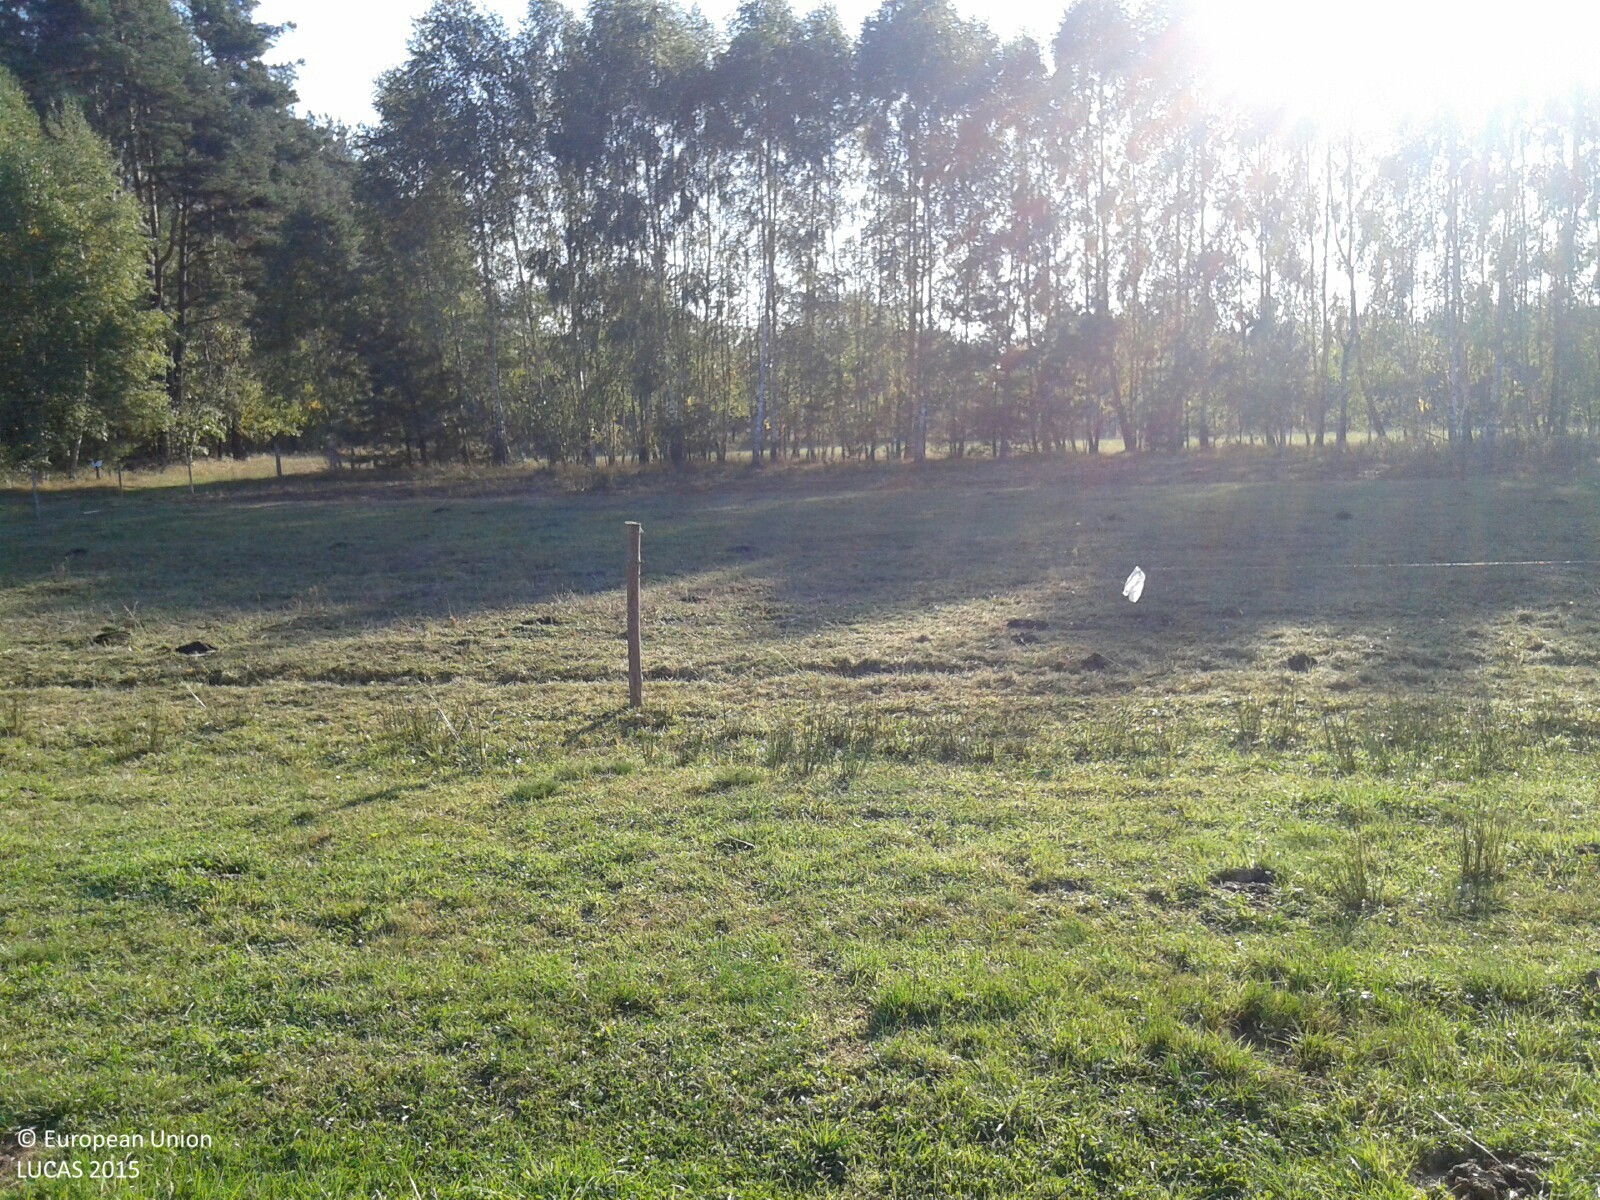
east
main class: Grassland
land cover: Grassland without tree/shrub cover
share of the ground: > 75 %
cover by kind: herbaceous plants 95 %, unconsolidated bare surface 5 %
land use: Agriculture (excluding fallow land and kitchen gardens)
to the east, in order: Grassland without tree/shrub cover; Fences; Grassland without tree/shrub cover; Fences; Broadleaved woodland; Grassland without tree/shrub cover; Pine dominated coniferous woodland; Grassland without tree/shrub cover; Other cereals; Lines of trees; Paved roads, cycling and walking lanes; Lines of trees; Grassland without tree/shrub cover; Tracks; Fences; Broadleaved woodland
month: September
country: PL
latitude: 52.6258
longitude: 21.9497
